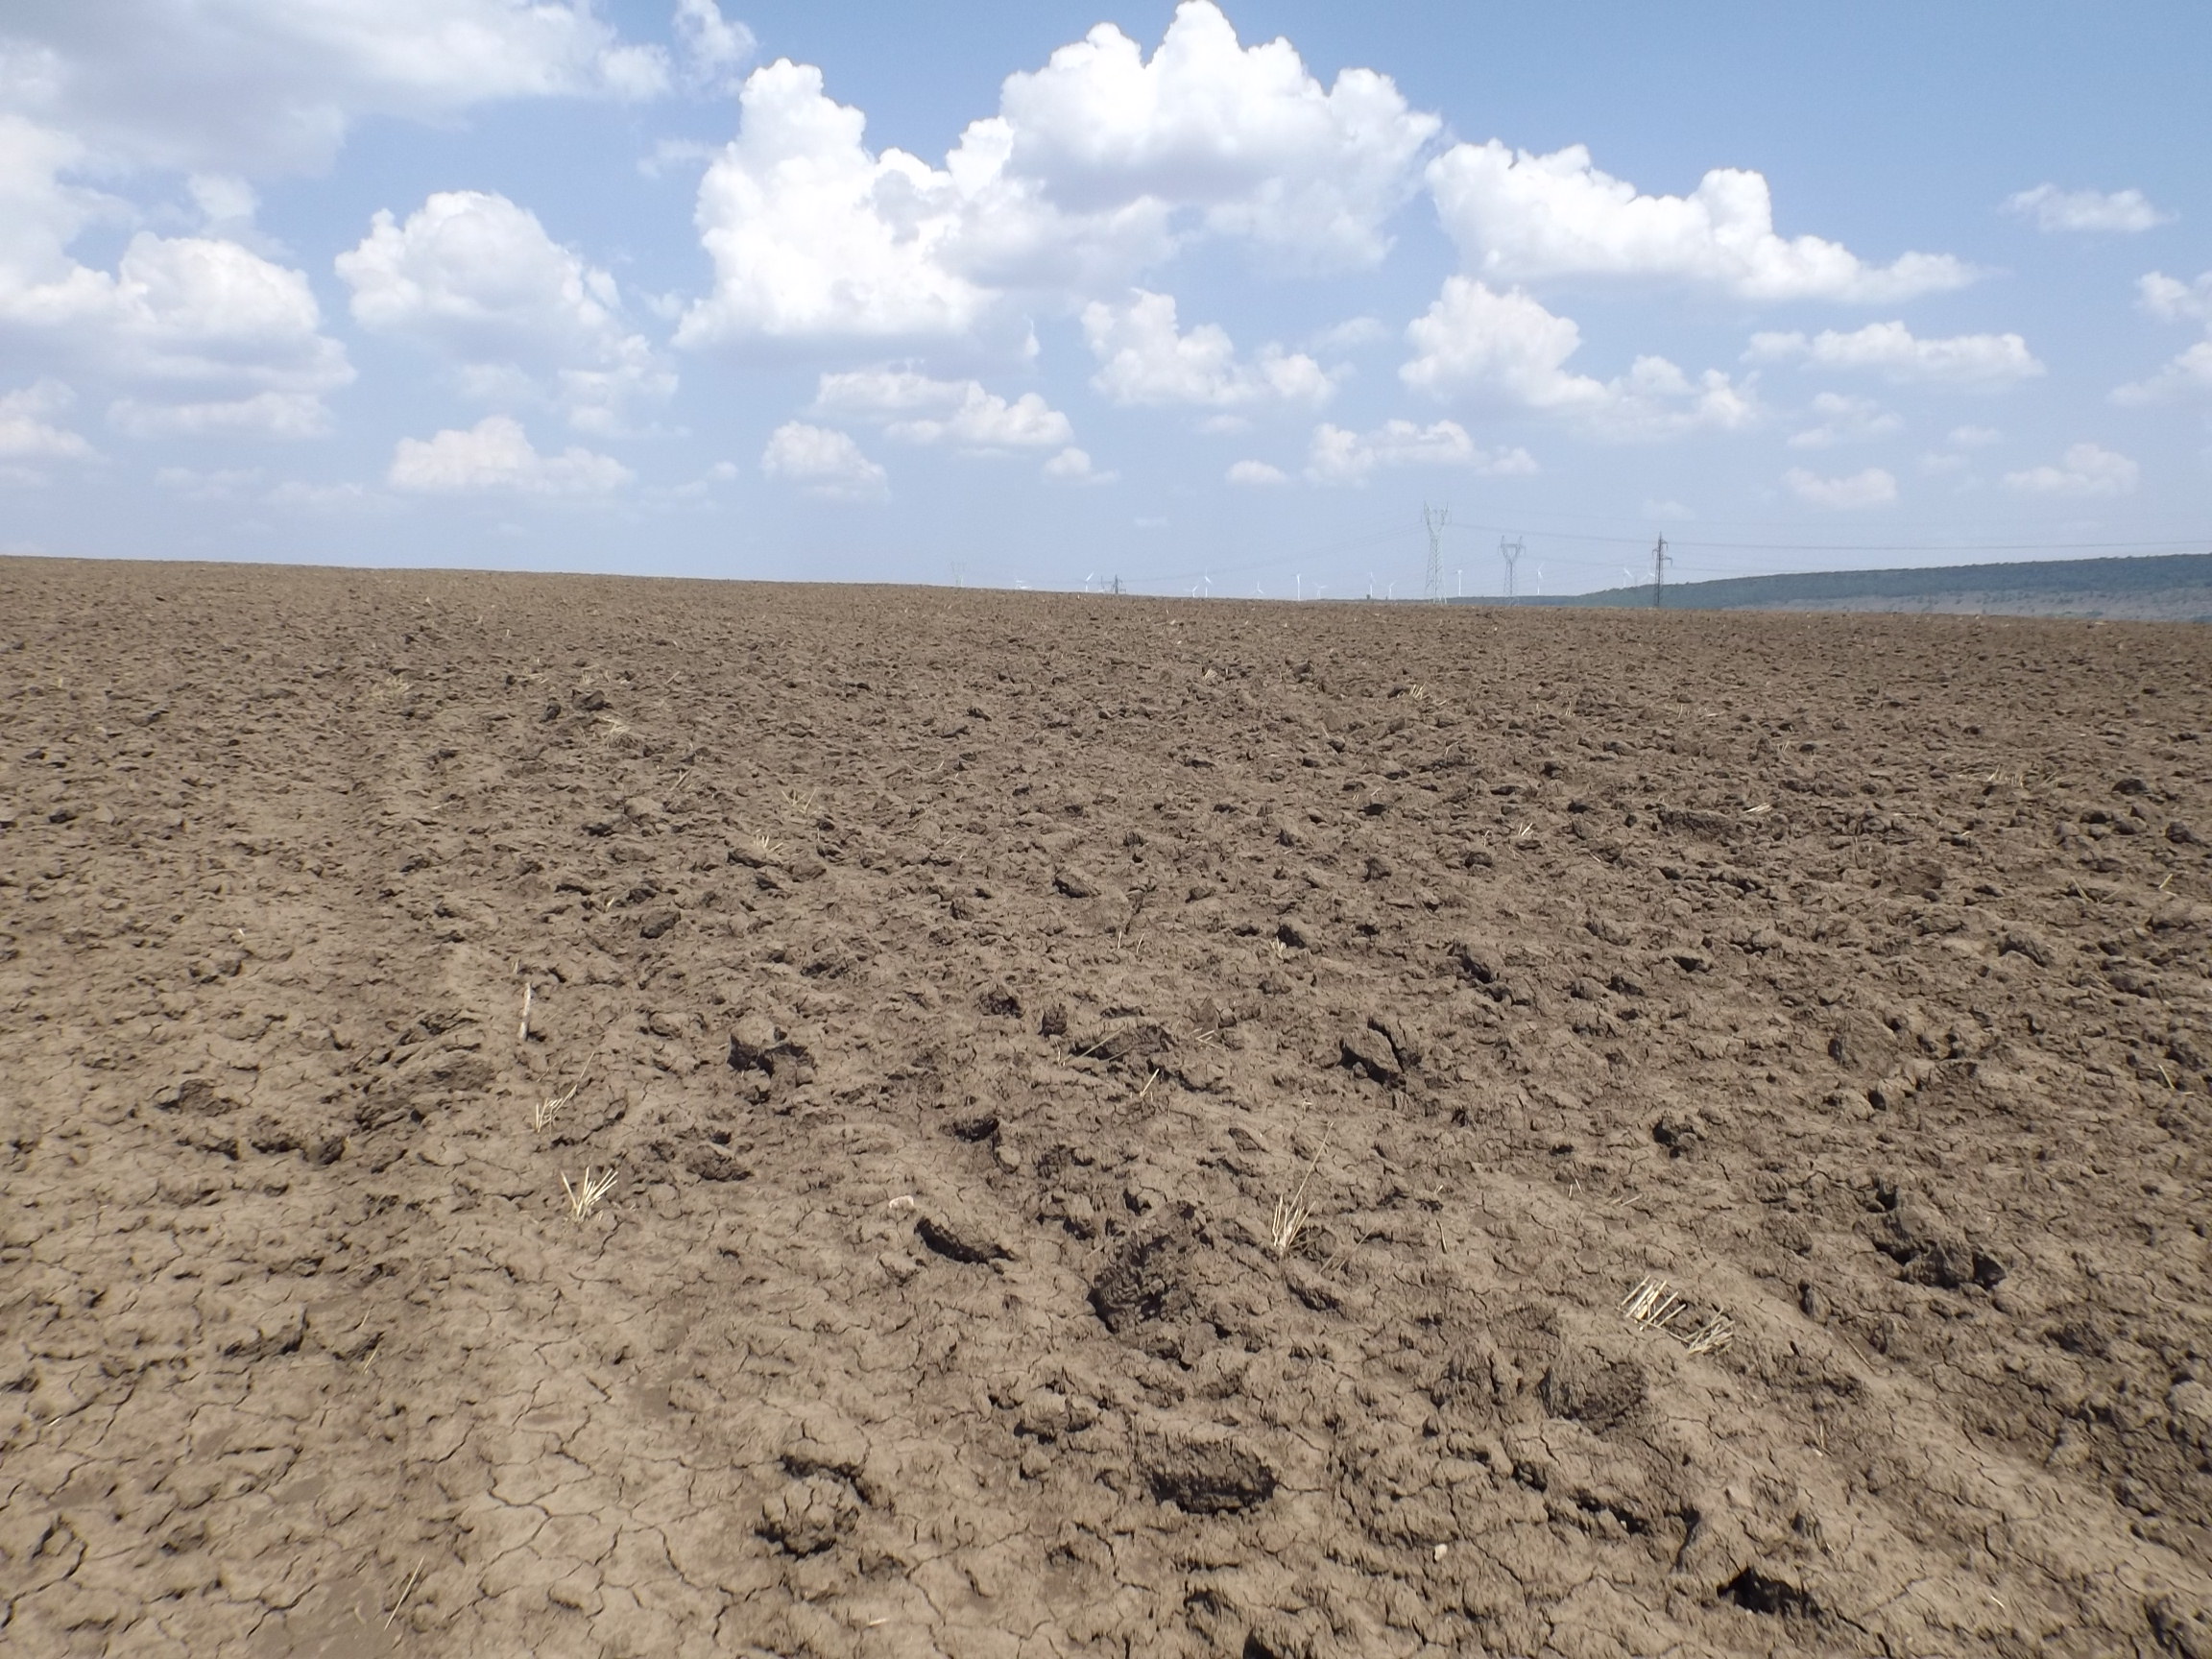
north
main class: Cropland
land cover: Common wheat
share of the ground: < 10 %
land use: Agriculture (excluding fallow land and kitchen gardens)
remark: Harvested field
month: August
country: BG
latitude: 43.3147
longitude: 27.5776
